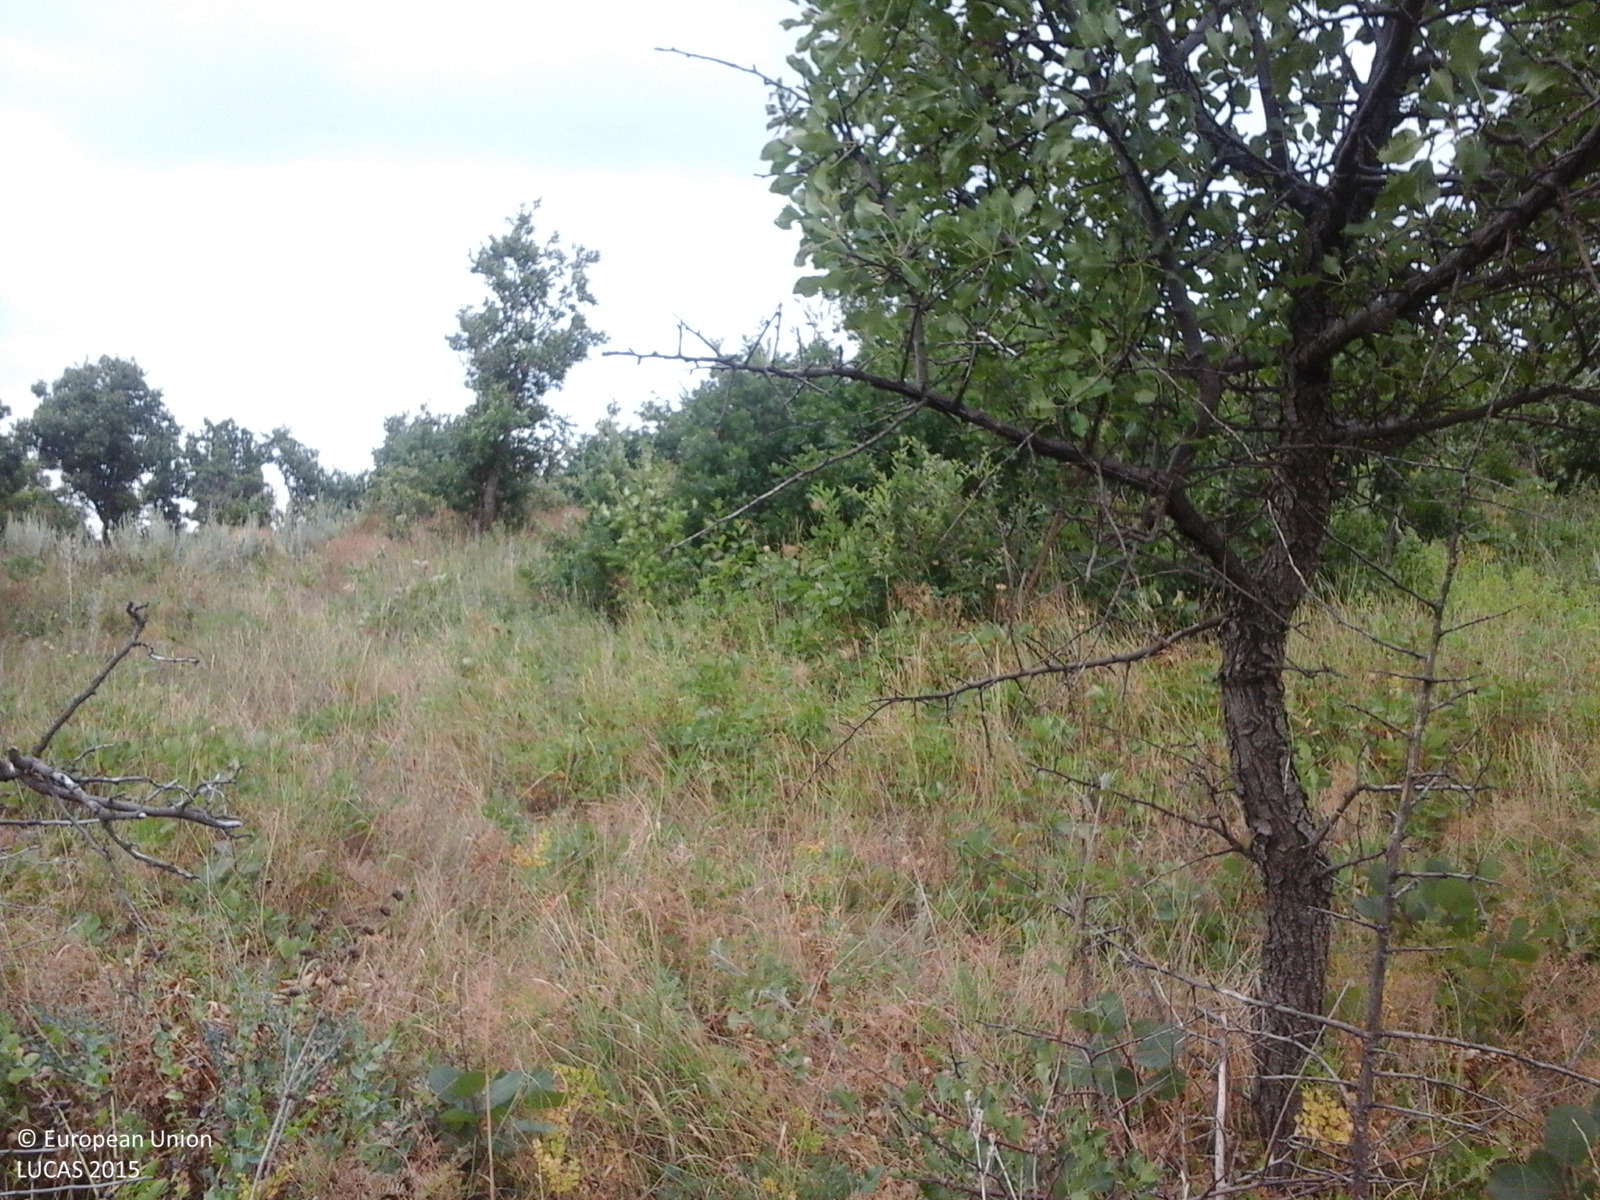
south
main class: Shrubland
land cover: Shrubland with sparse tree cover
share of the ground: > 75 %
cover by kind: shrubs 75 %, herbaceous plants 20 %, broadleaved forest trees 5 %
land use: Agriculture (excluding fallow land and kitchen gardens)
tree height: > 5 m
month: August
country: RO
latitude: 44.8935
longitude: 28.6581
